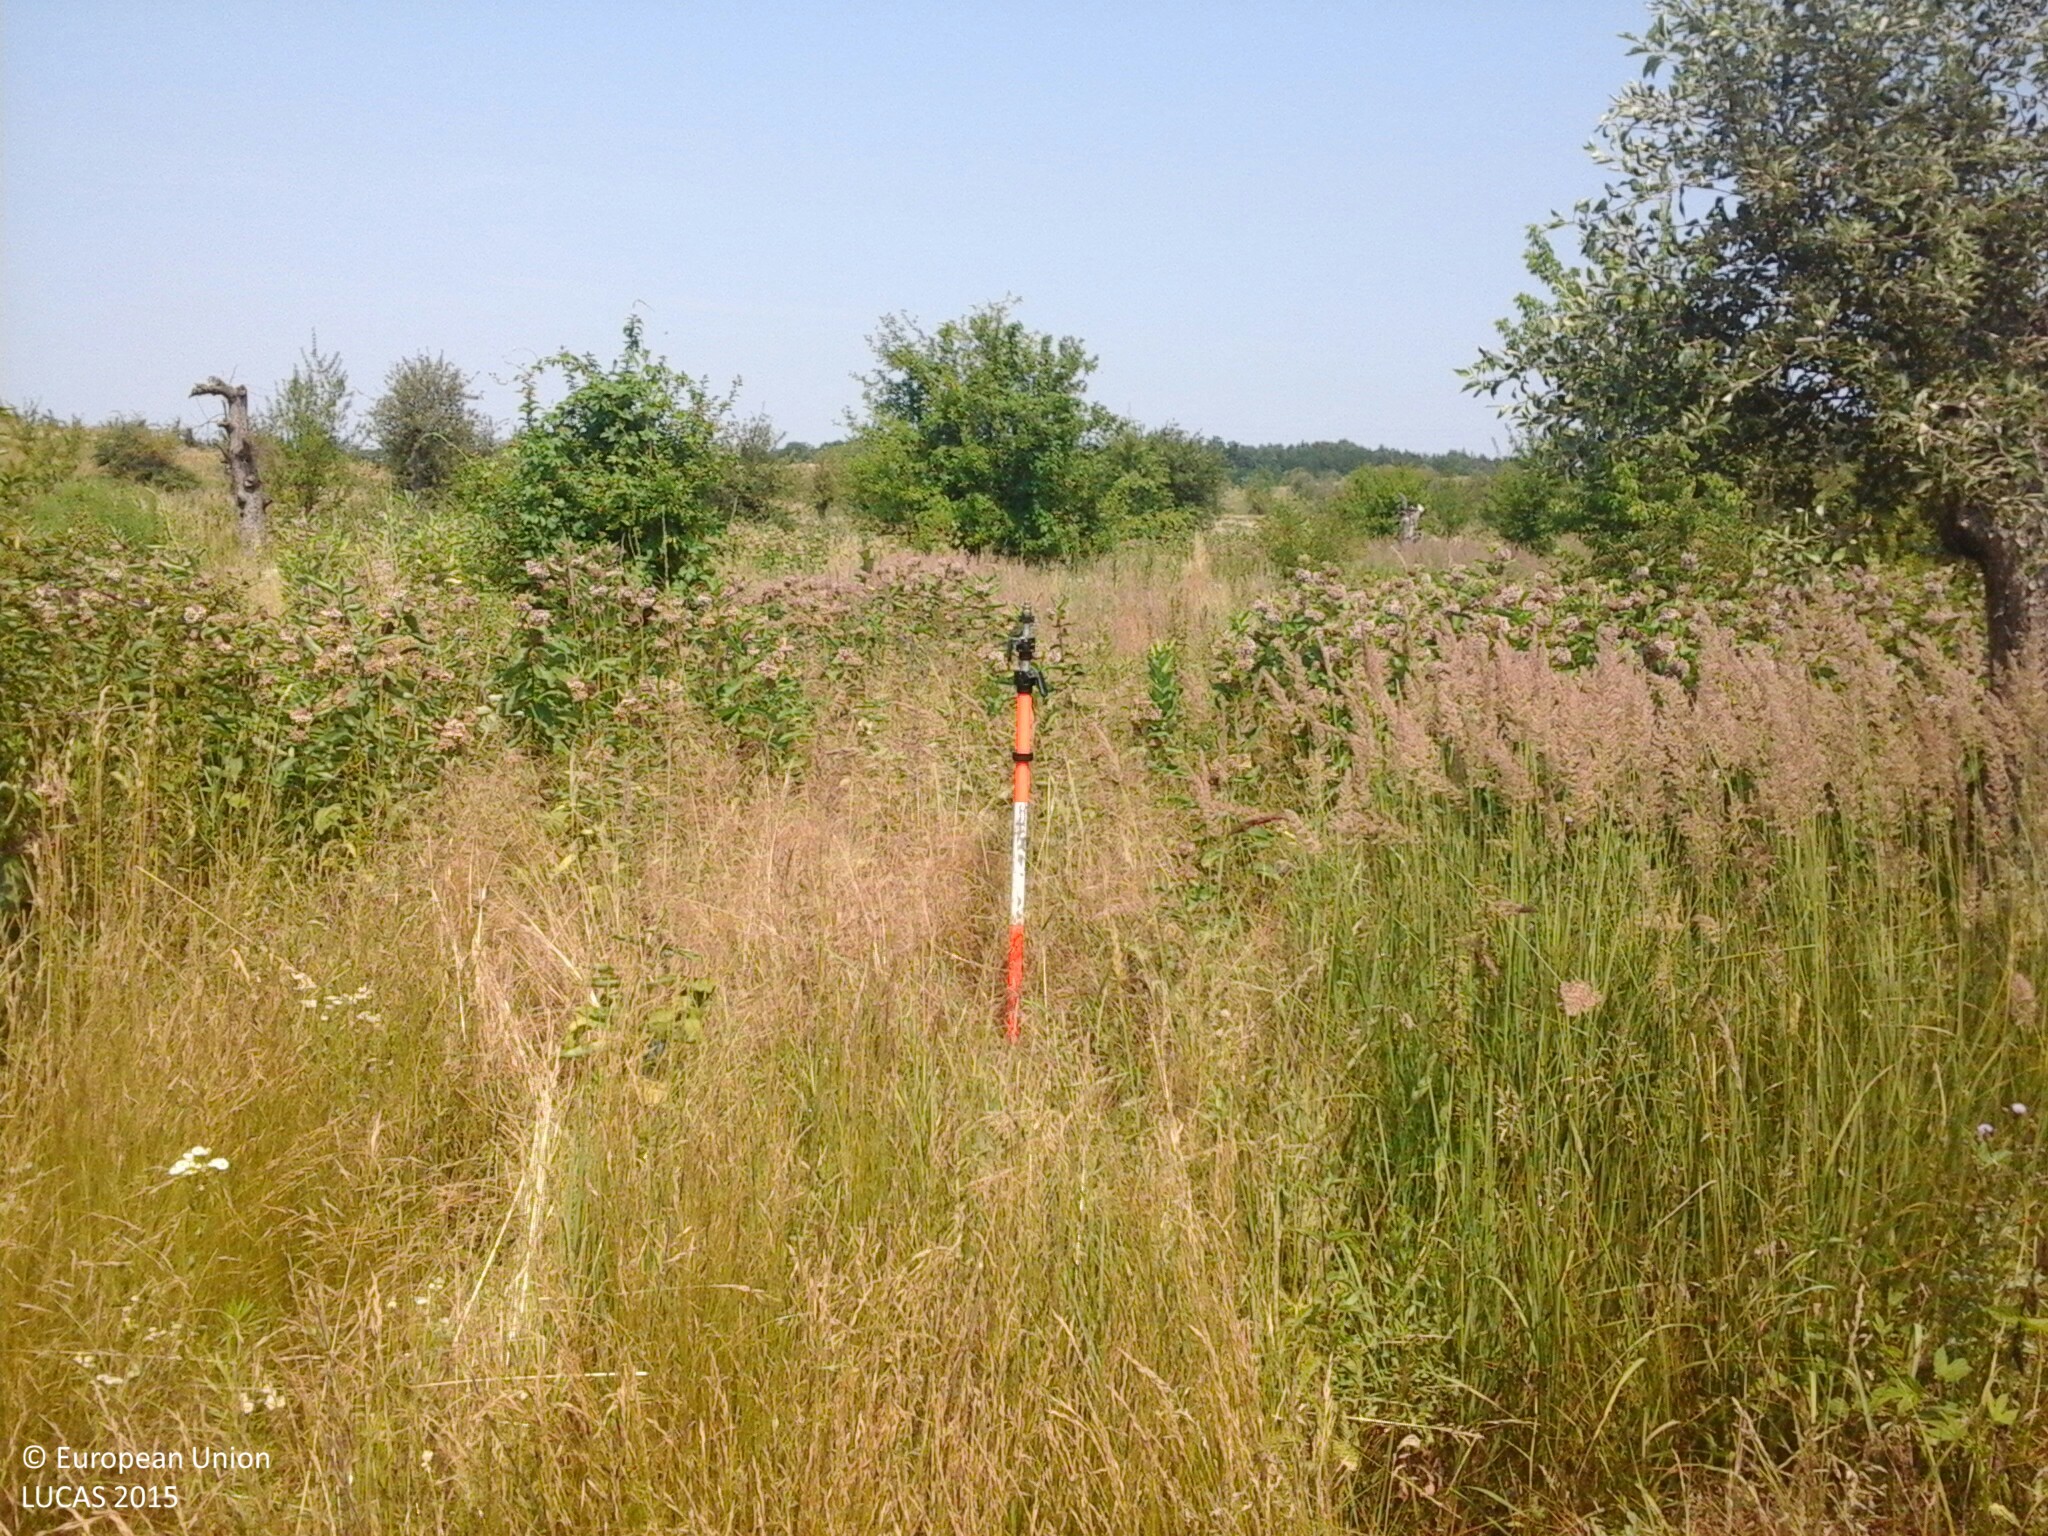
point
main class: Grassland
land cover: Grassland with sparse tree/shrub cover
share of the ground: > 75 %
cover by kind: herbaceous plants 90 %, broadleaved forest trees 5 %, shrubs 5 %
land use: Abandoned areas
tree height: < 5 m
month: July
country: HU
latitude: 48.1207
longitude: 22.2407
